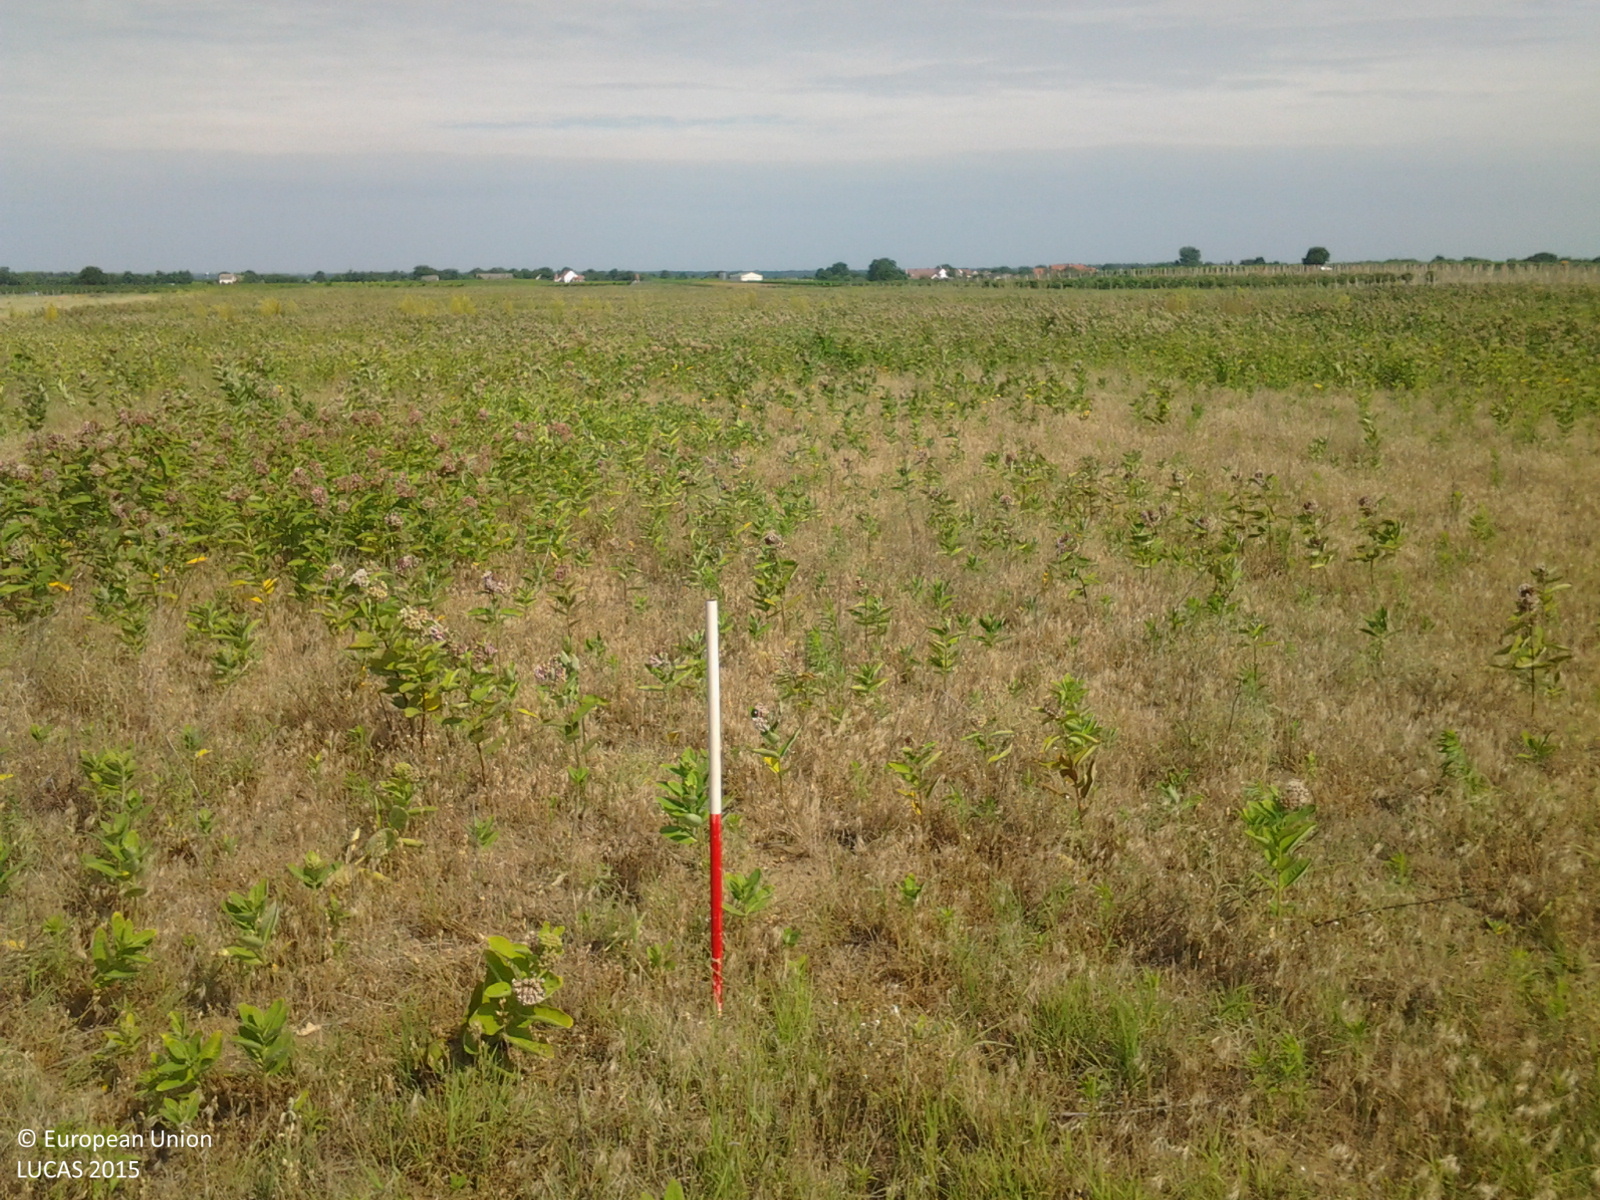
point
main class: Grassland
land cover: Spontaneously vegetated surfaces
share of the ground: > 75 %
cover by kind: herbaceous plants 100 %
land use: Fallow land
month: June
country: HU
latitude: 46.3748
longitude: 19.1536
